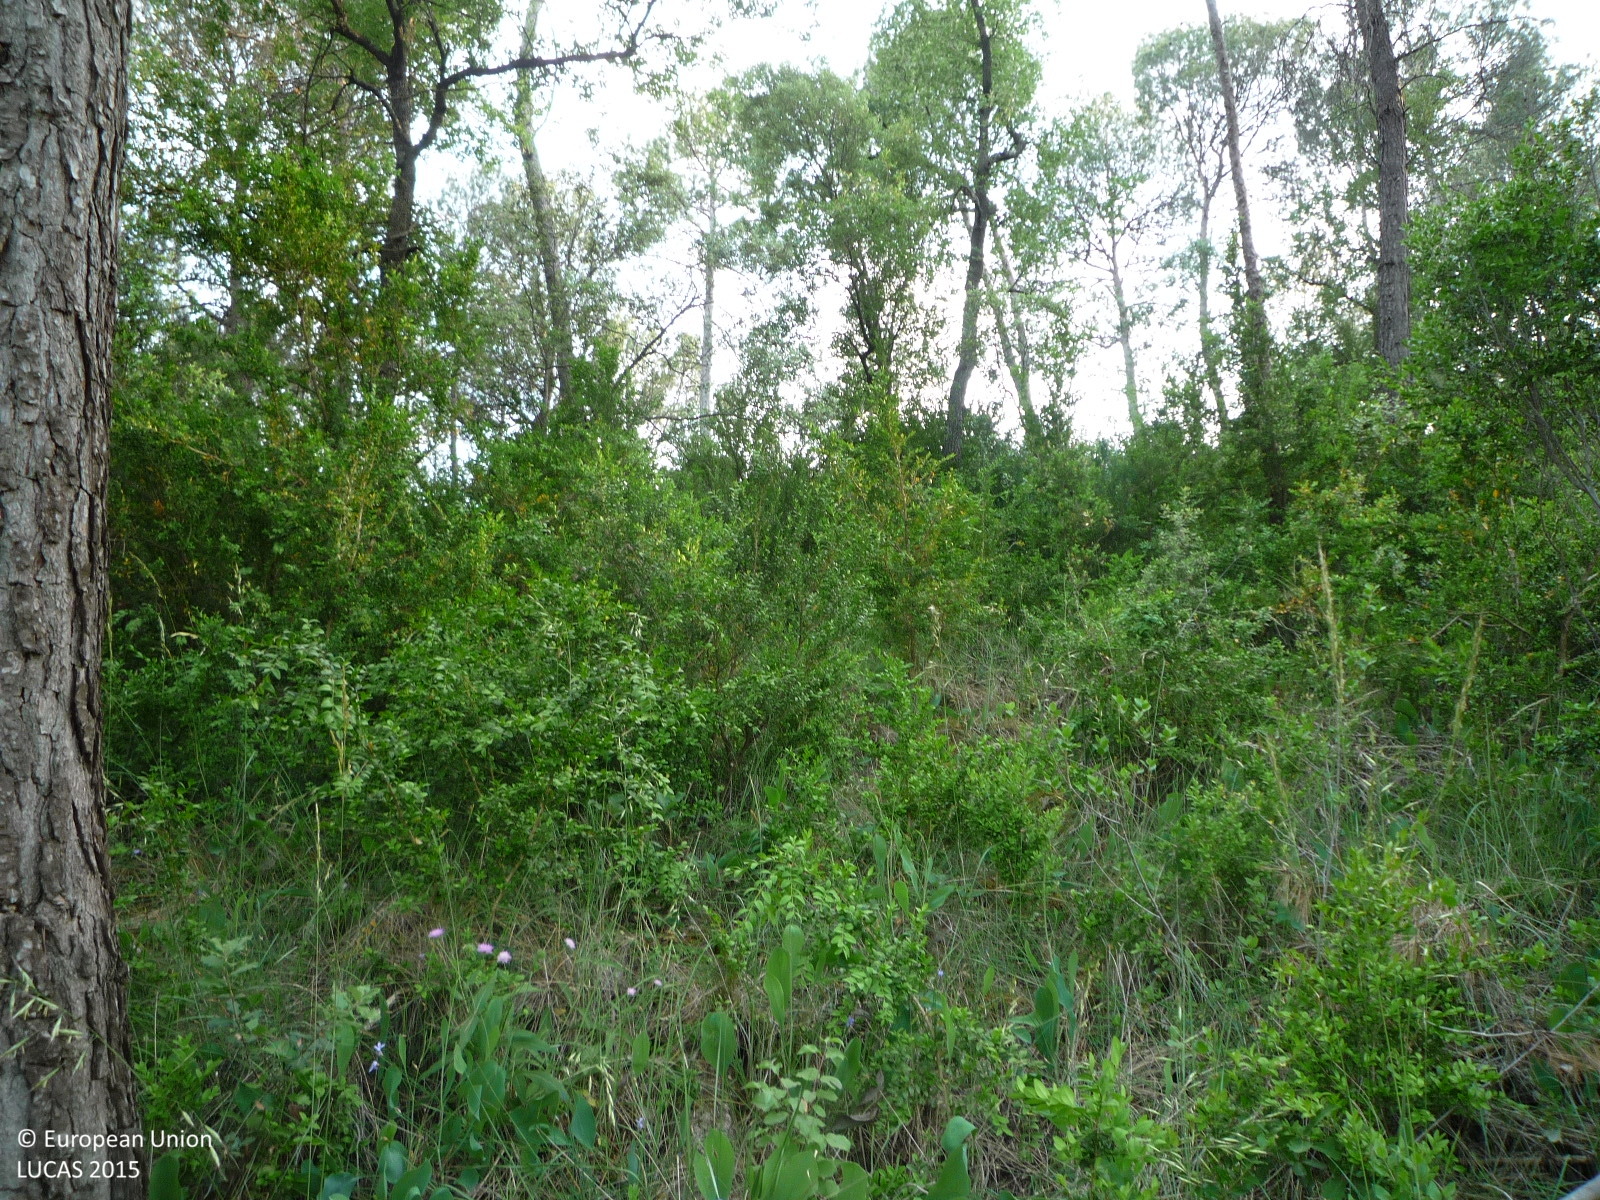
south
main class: Woodland
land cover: Pine dominated mixed woodland
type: coniferous forest of the mediterranean region
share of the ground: > 75 %
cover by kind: coniferous forest trees 60 %, broadleaved forest trees 20 %, herbaceous plants 20 %
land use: Forestry
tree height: > 5 m
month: May
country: ES
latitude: 41.8439
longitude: 1.9577
